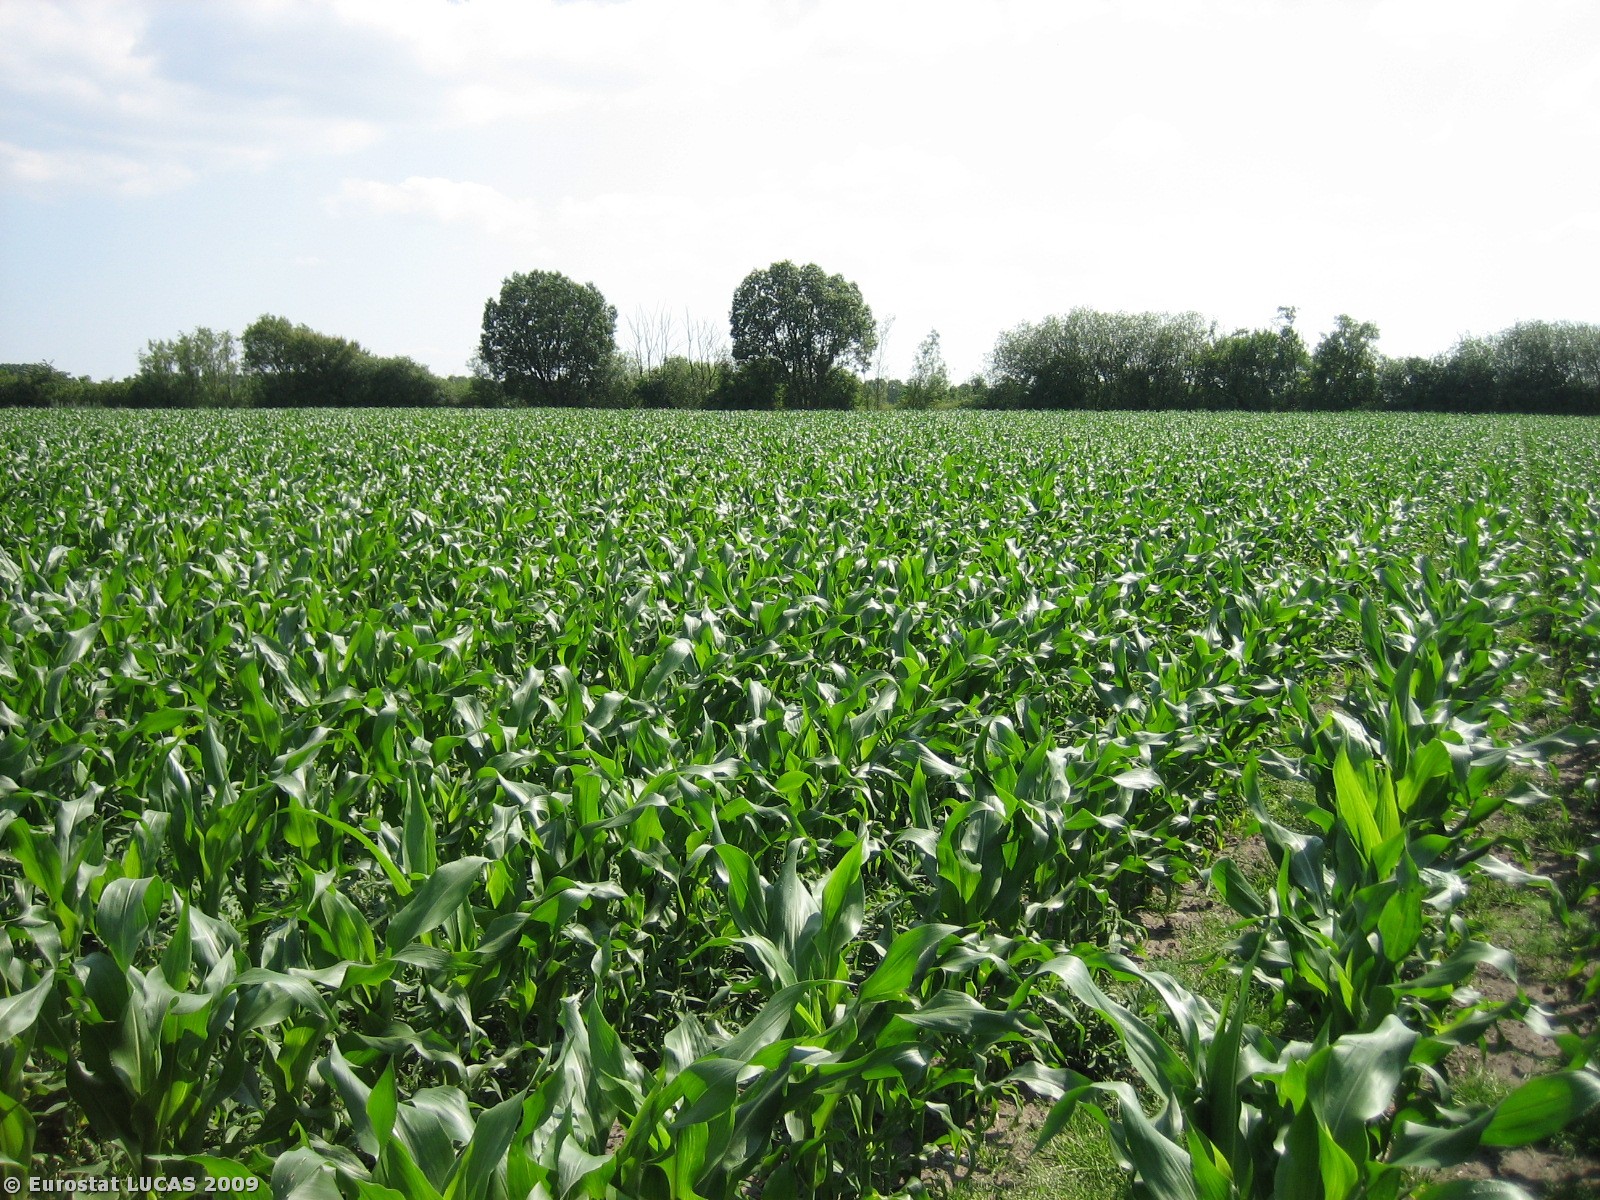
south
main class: Cropland
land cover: Maize
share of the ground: 50 - 75 %
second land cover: Spontaneously vegetated surfaces
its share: 10 - 25 %
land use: Agriculture (excluding fallow land and kitchen gardens)
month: July
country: DK
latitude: 55.3929
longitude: 9.0063
